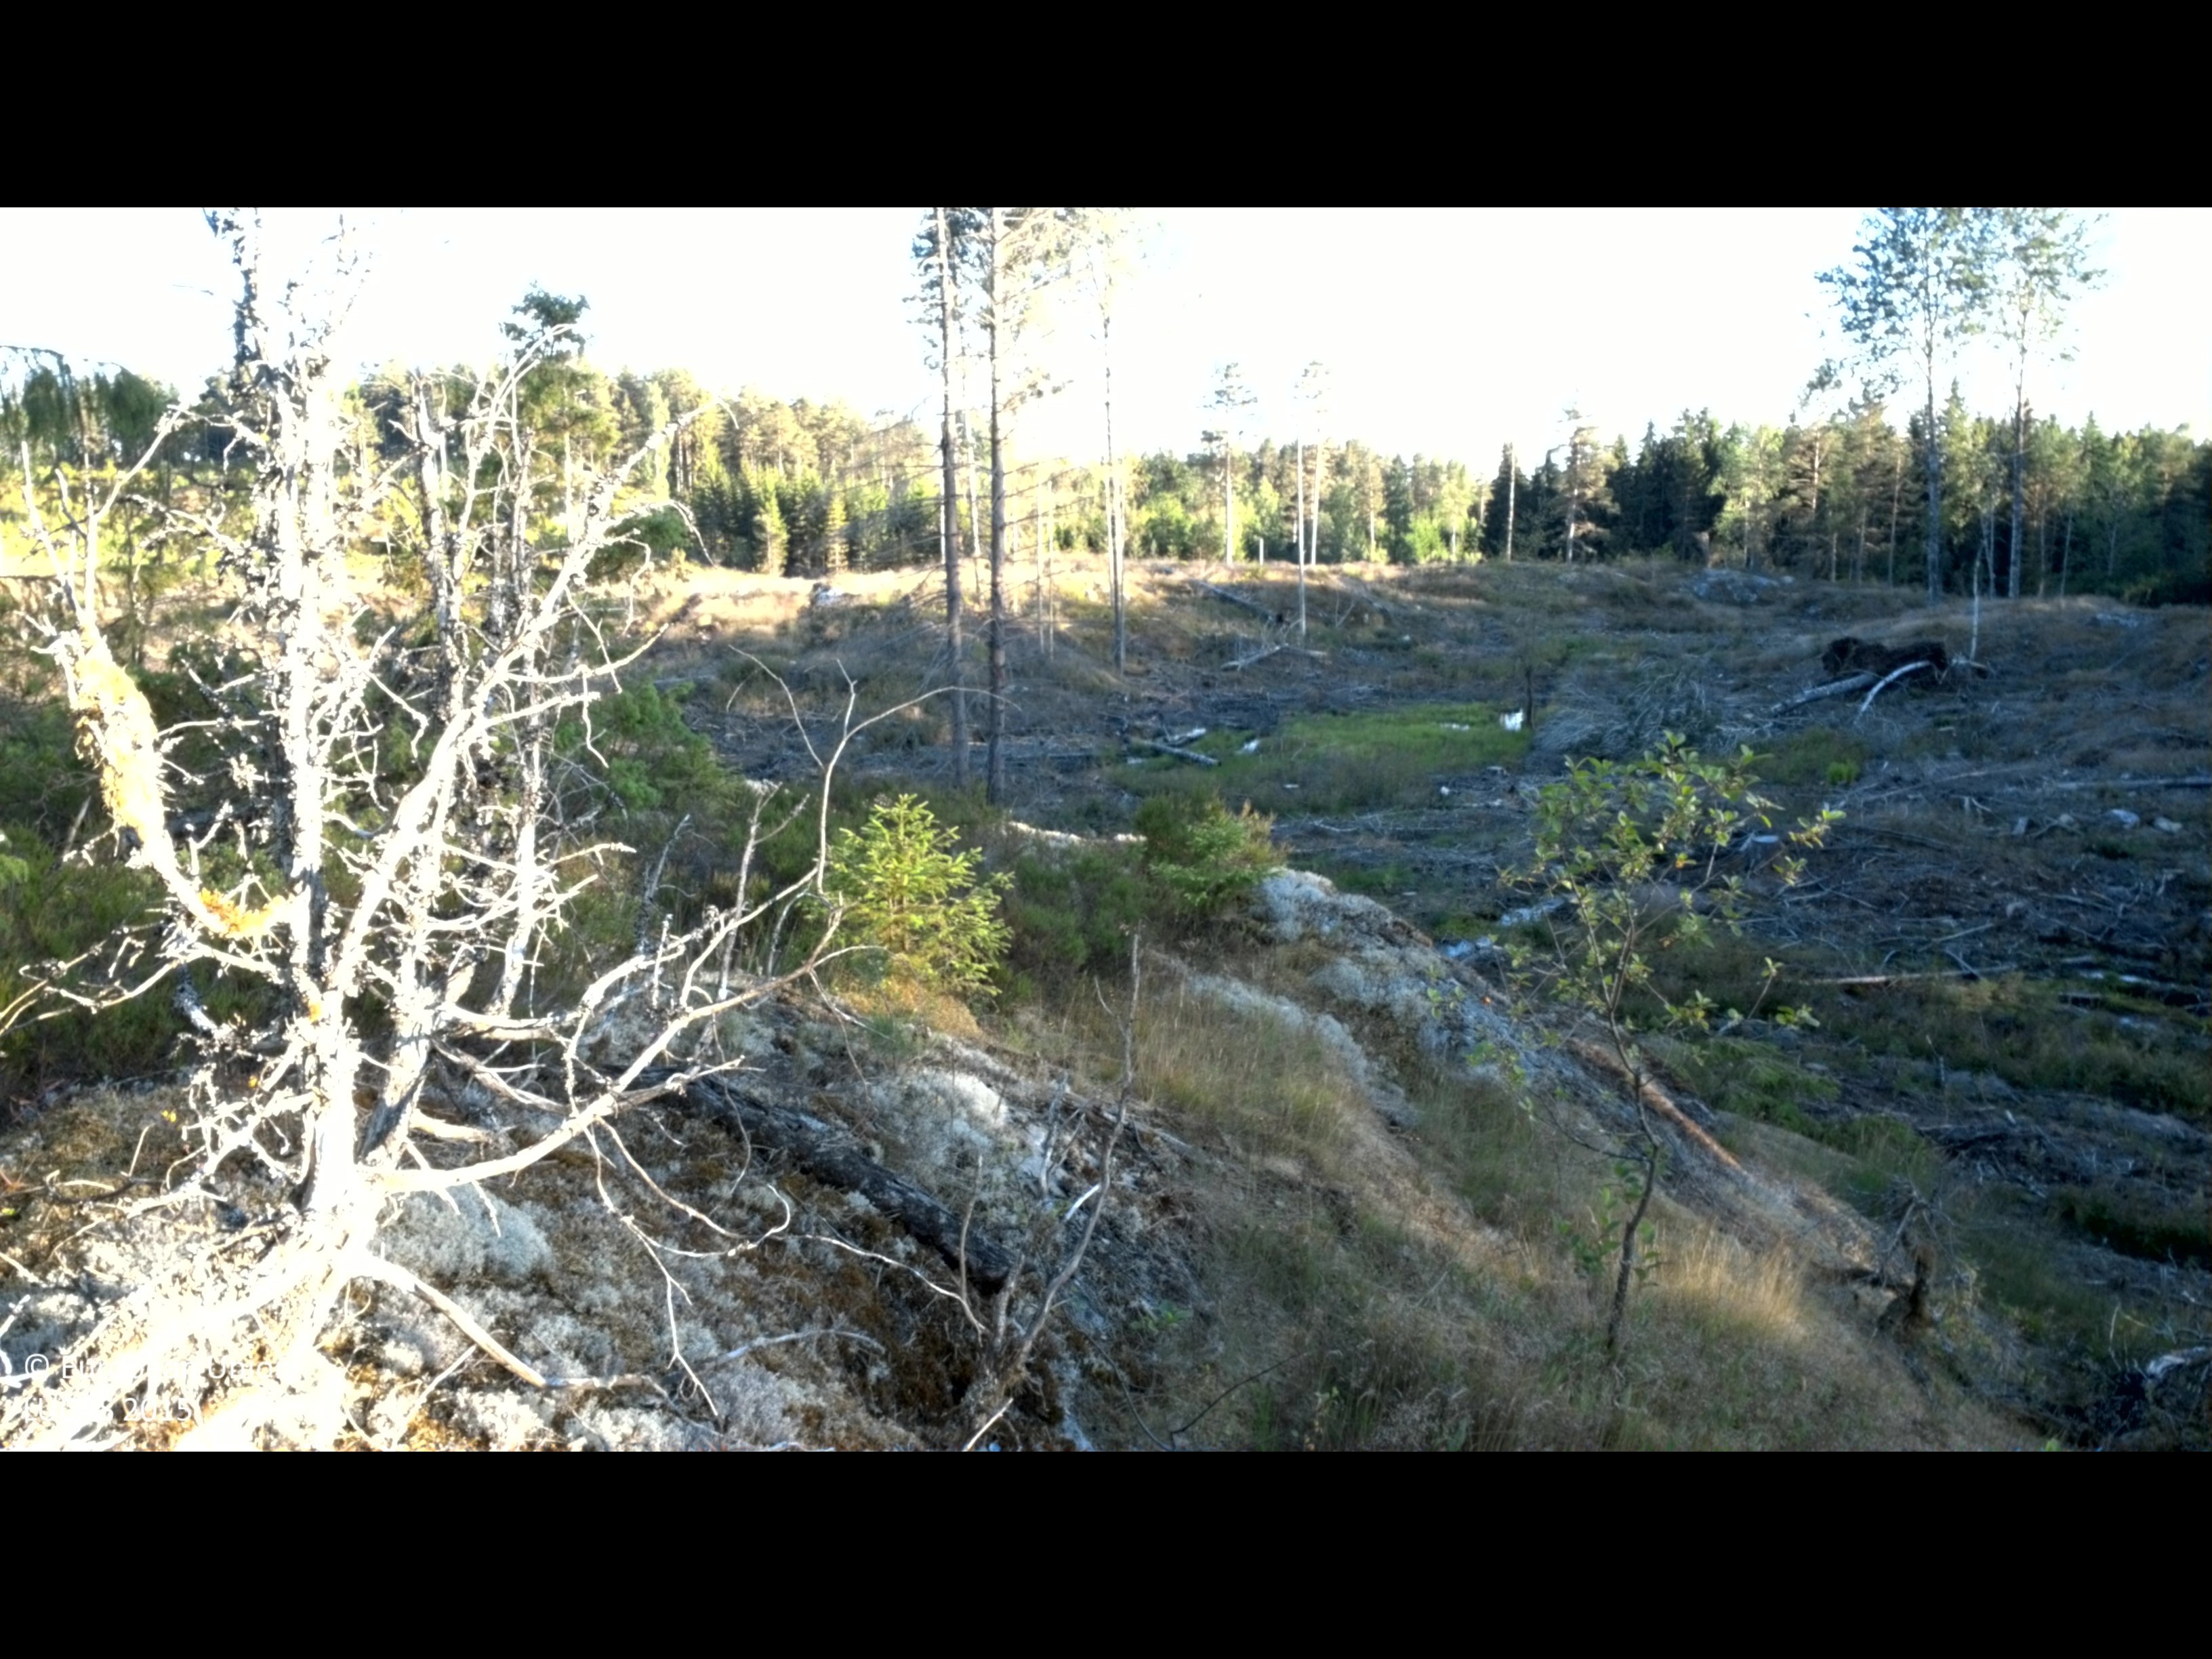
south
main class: Shrubland
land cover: Shrubland with sparse tree cover
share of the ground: 50 - 75 %
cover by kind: shrubs 55 %, herbaceous plants 20 %, lichens and mosses 20 %, broadleaved forest trees 5 %
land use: Semi-natural and natural areas not in use
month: July
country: SE
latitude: 58.2255
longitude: 16.4840
